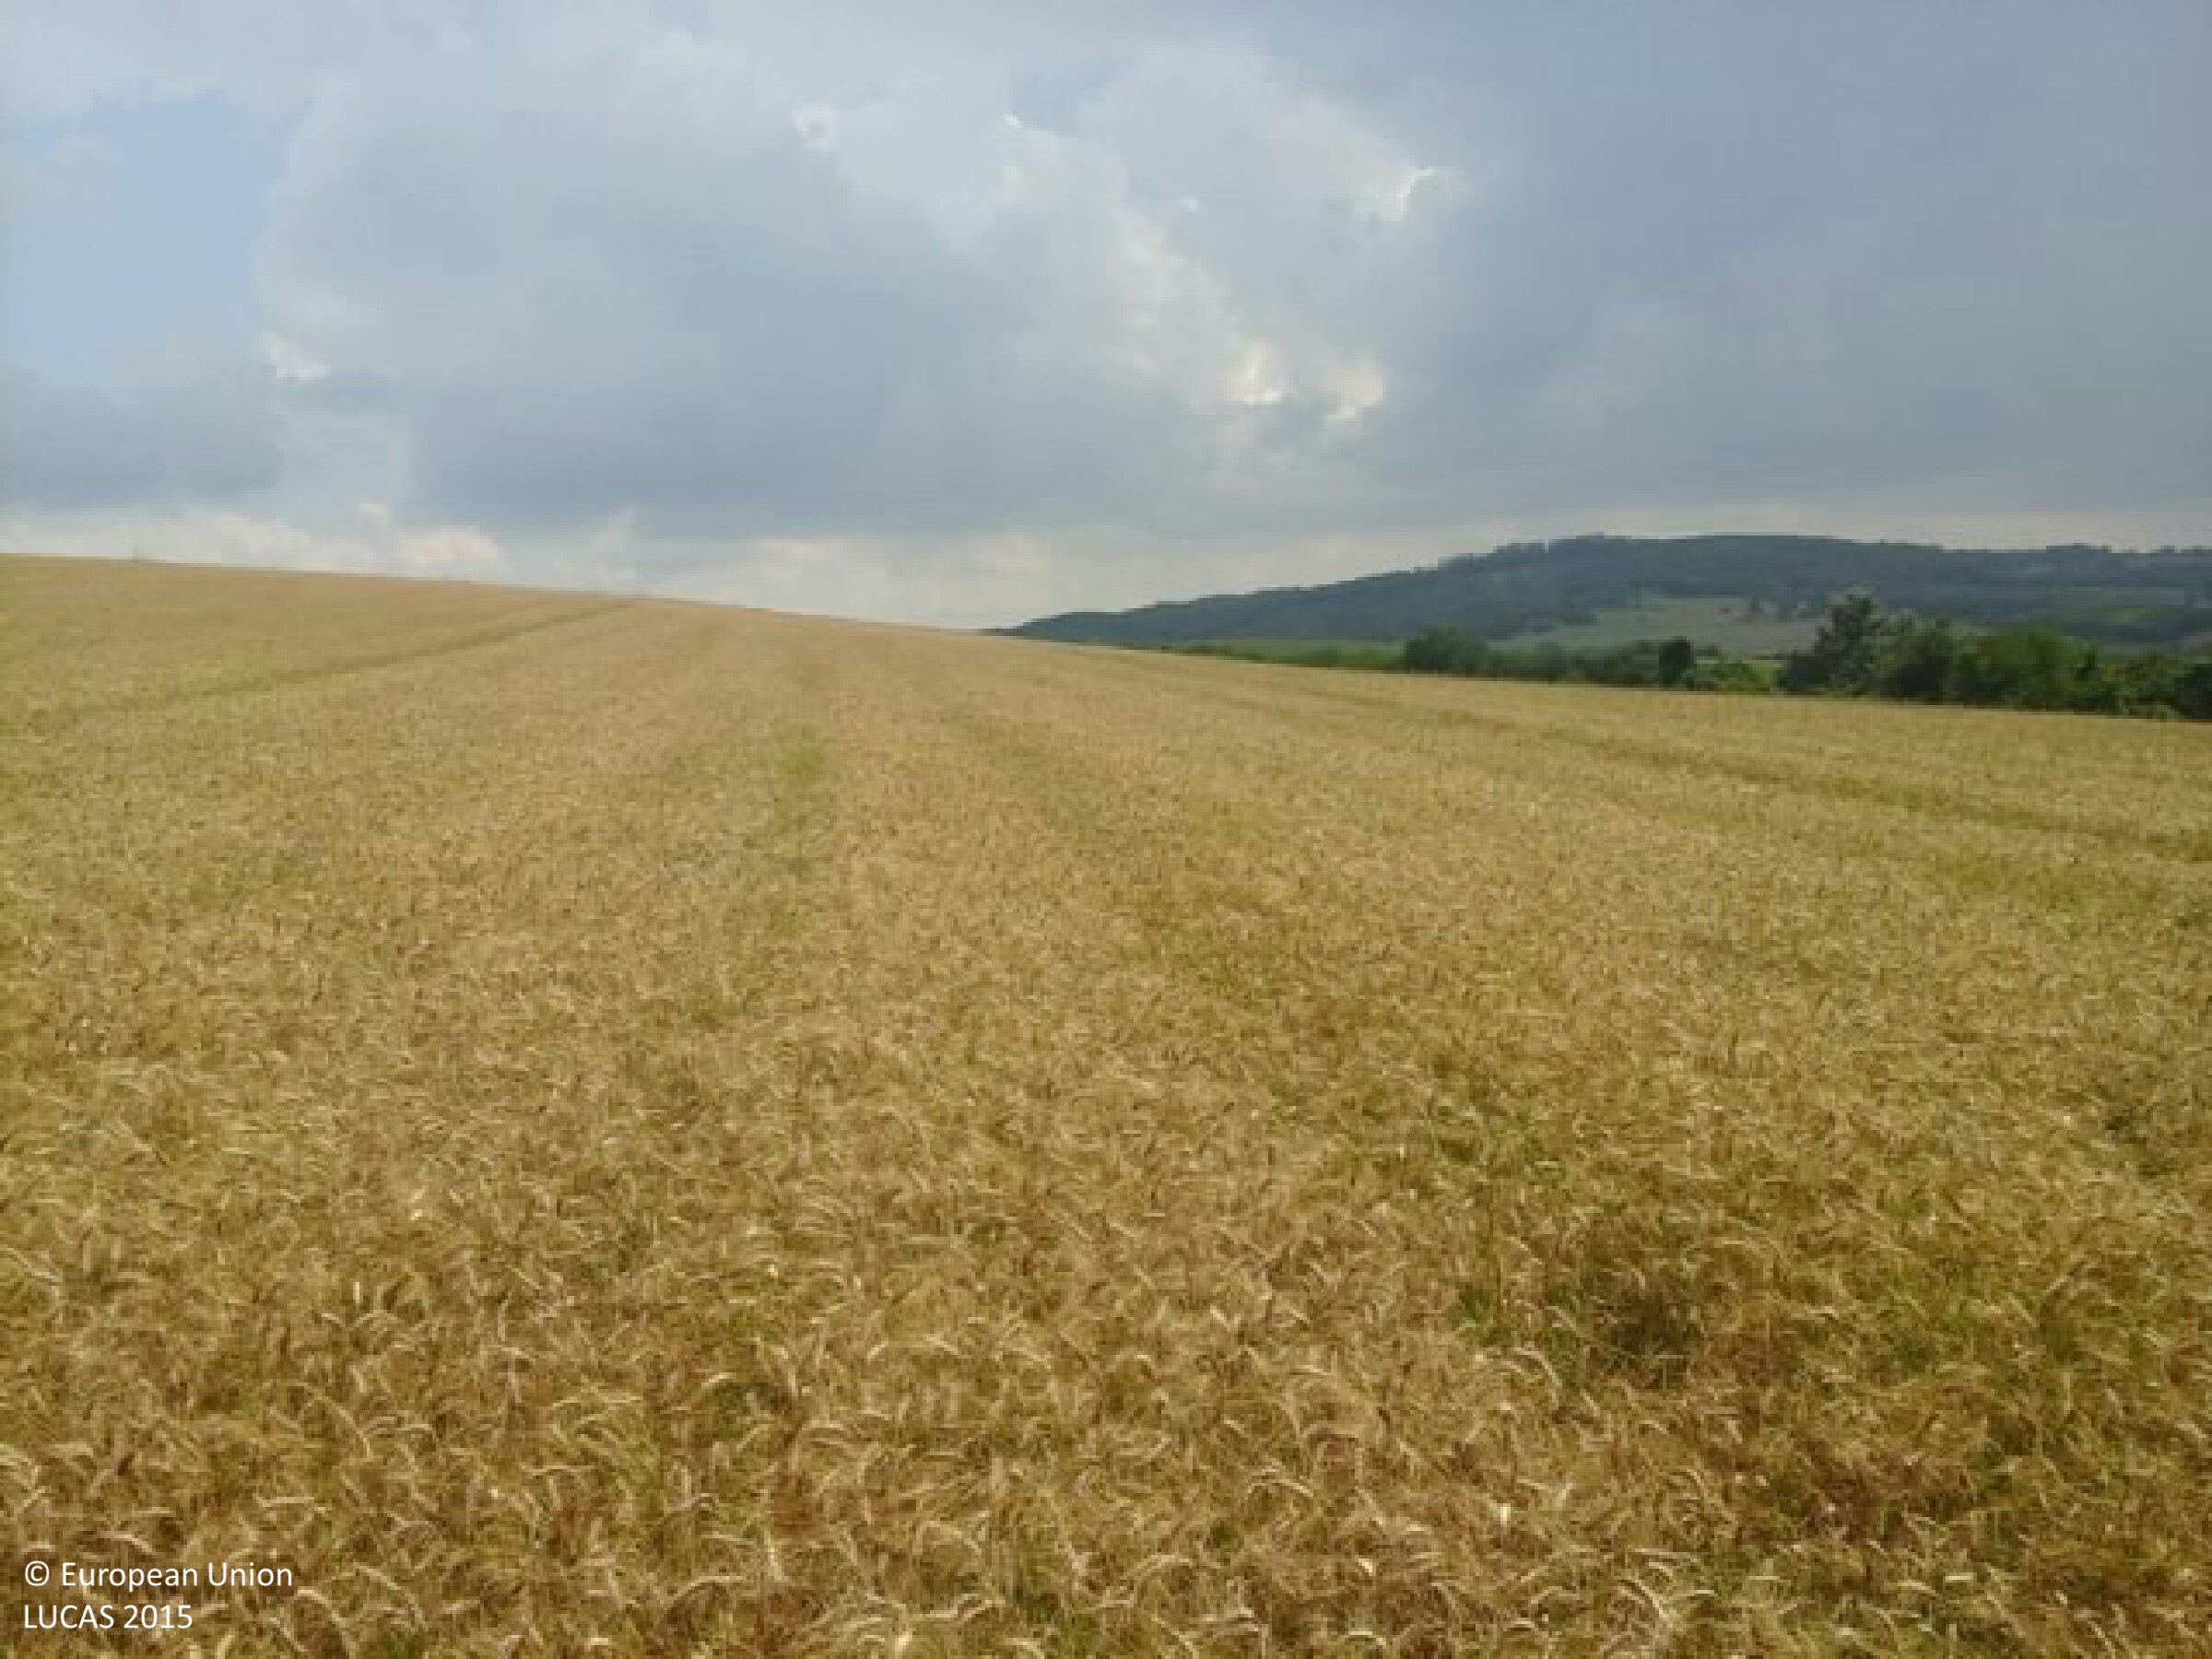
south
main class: Cropland
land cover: Triticale
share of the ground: > 75 %
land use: Agriculture (excluding fallow land and kitchen gardens)
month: August
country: HU
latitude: 46.2001
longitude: 18.1846
